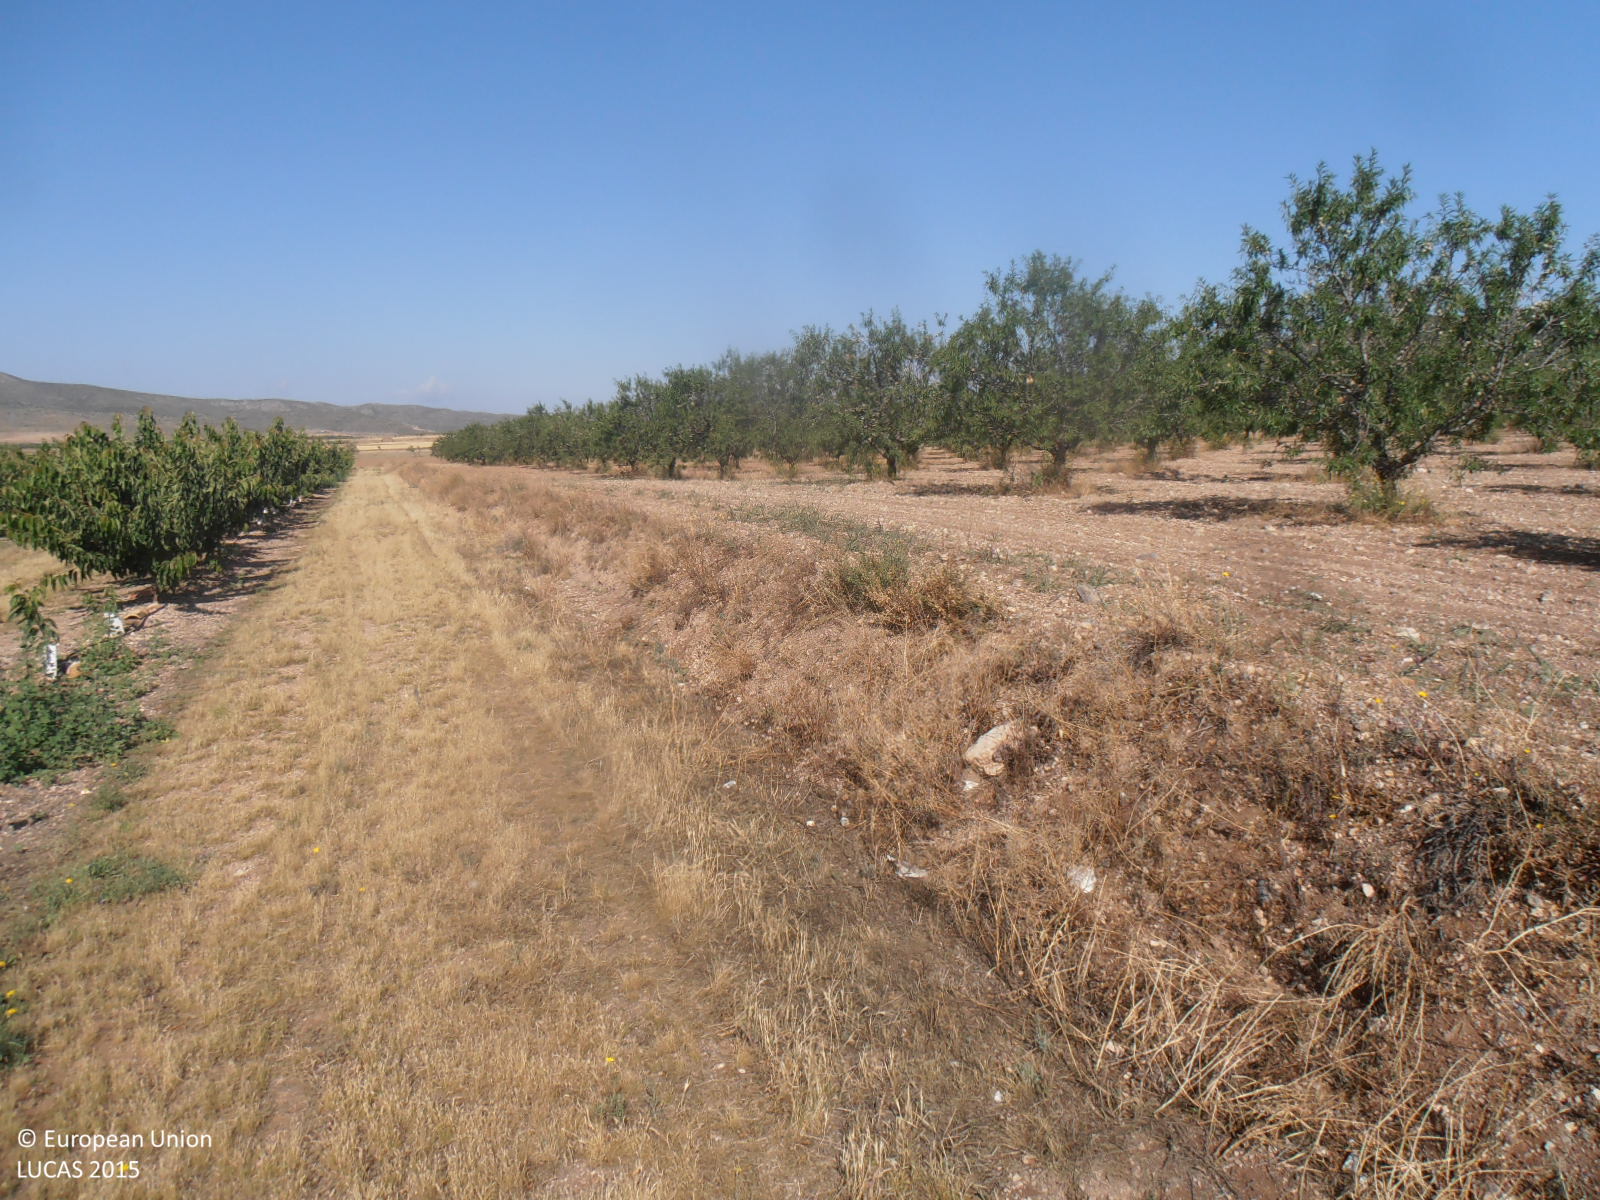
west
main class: Cropland
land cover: Cherry fruit
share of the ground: 25 - 50 %
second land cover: Spontaneously vegetated surfaces
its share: 50 - 75 %
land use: Agriculture (excluding fallow land and kitchen gardens)
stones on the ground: < 10 %
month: June
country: ES
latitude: 41.5674
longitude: -1.4298
